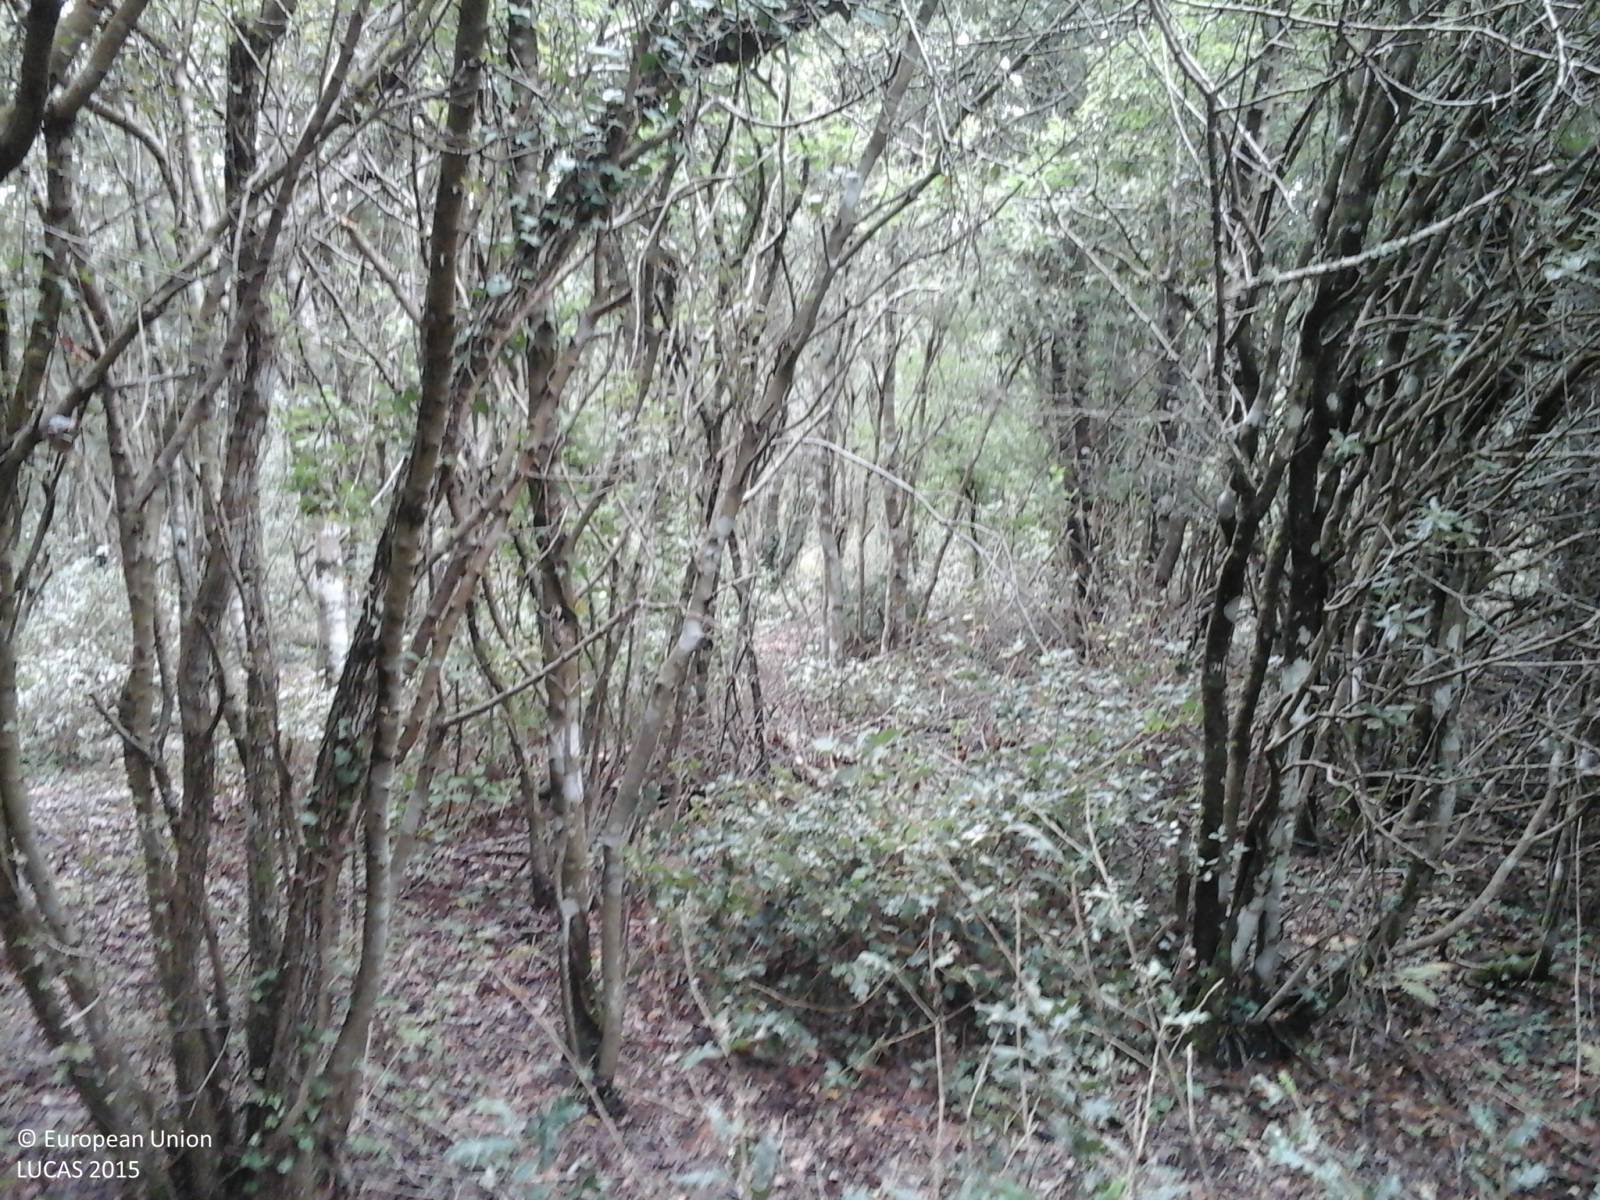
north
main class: Woodland
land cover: Broadleaved woodland
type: broadleaved evergreen forest
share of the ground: > 75 %
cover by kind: broadleaved forest trees 100 %
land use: Forestry
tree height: > 5 m
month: September
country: IT
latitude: 40.2403
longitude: 8.6787
